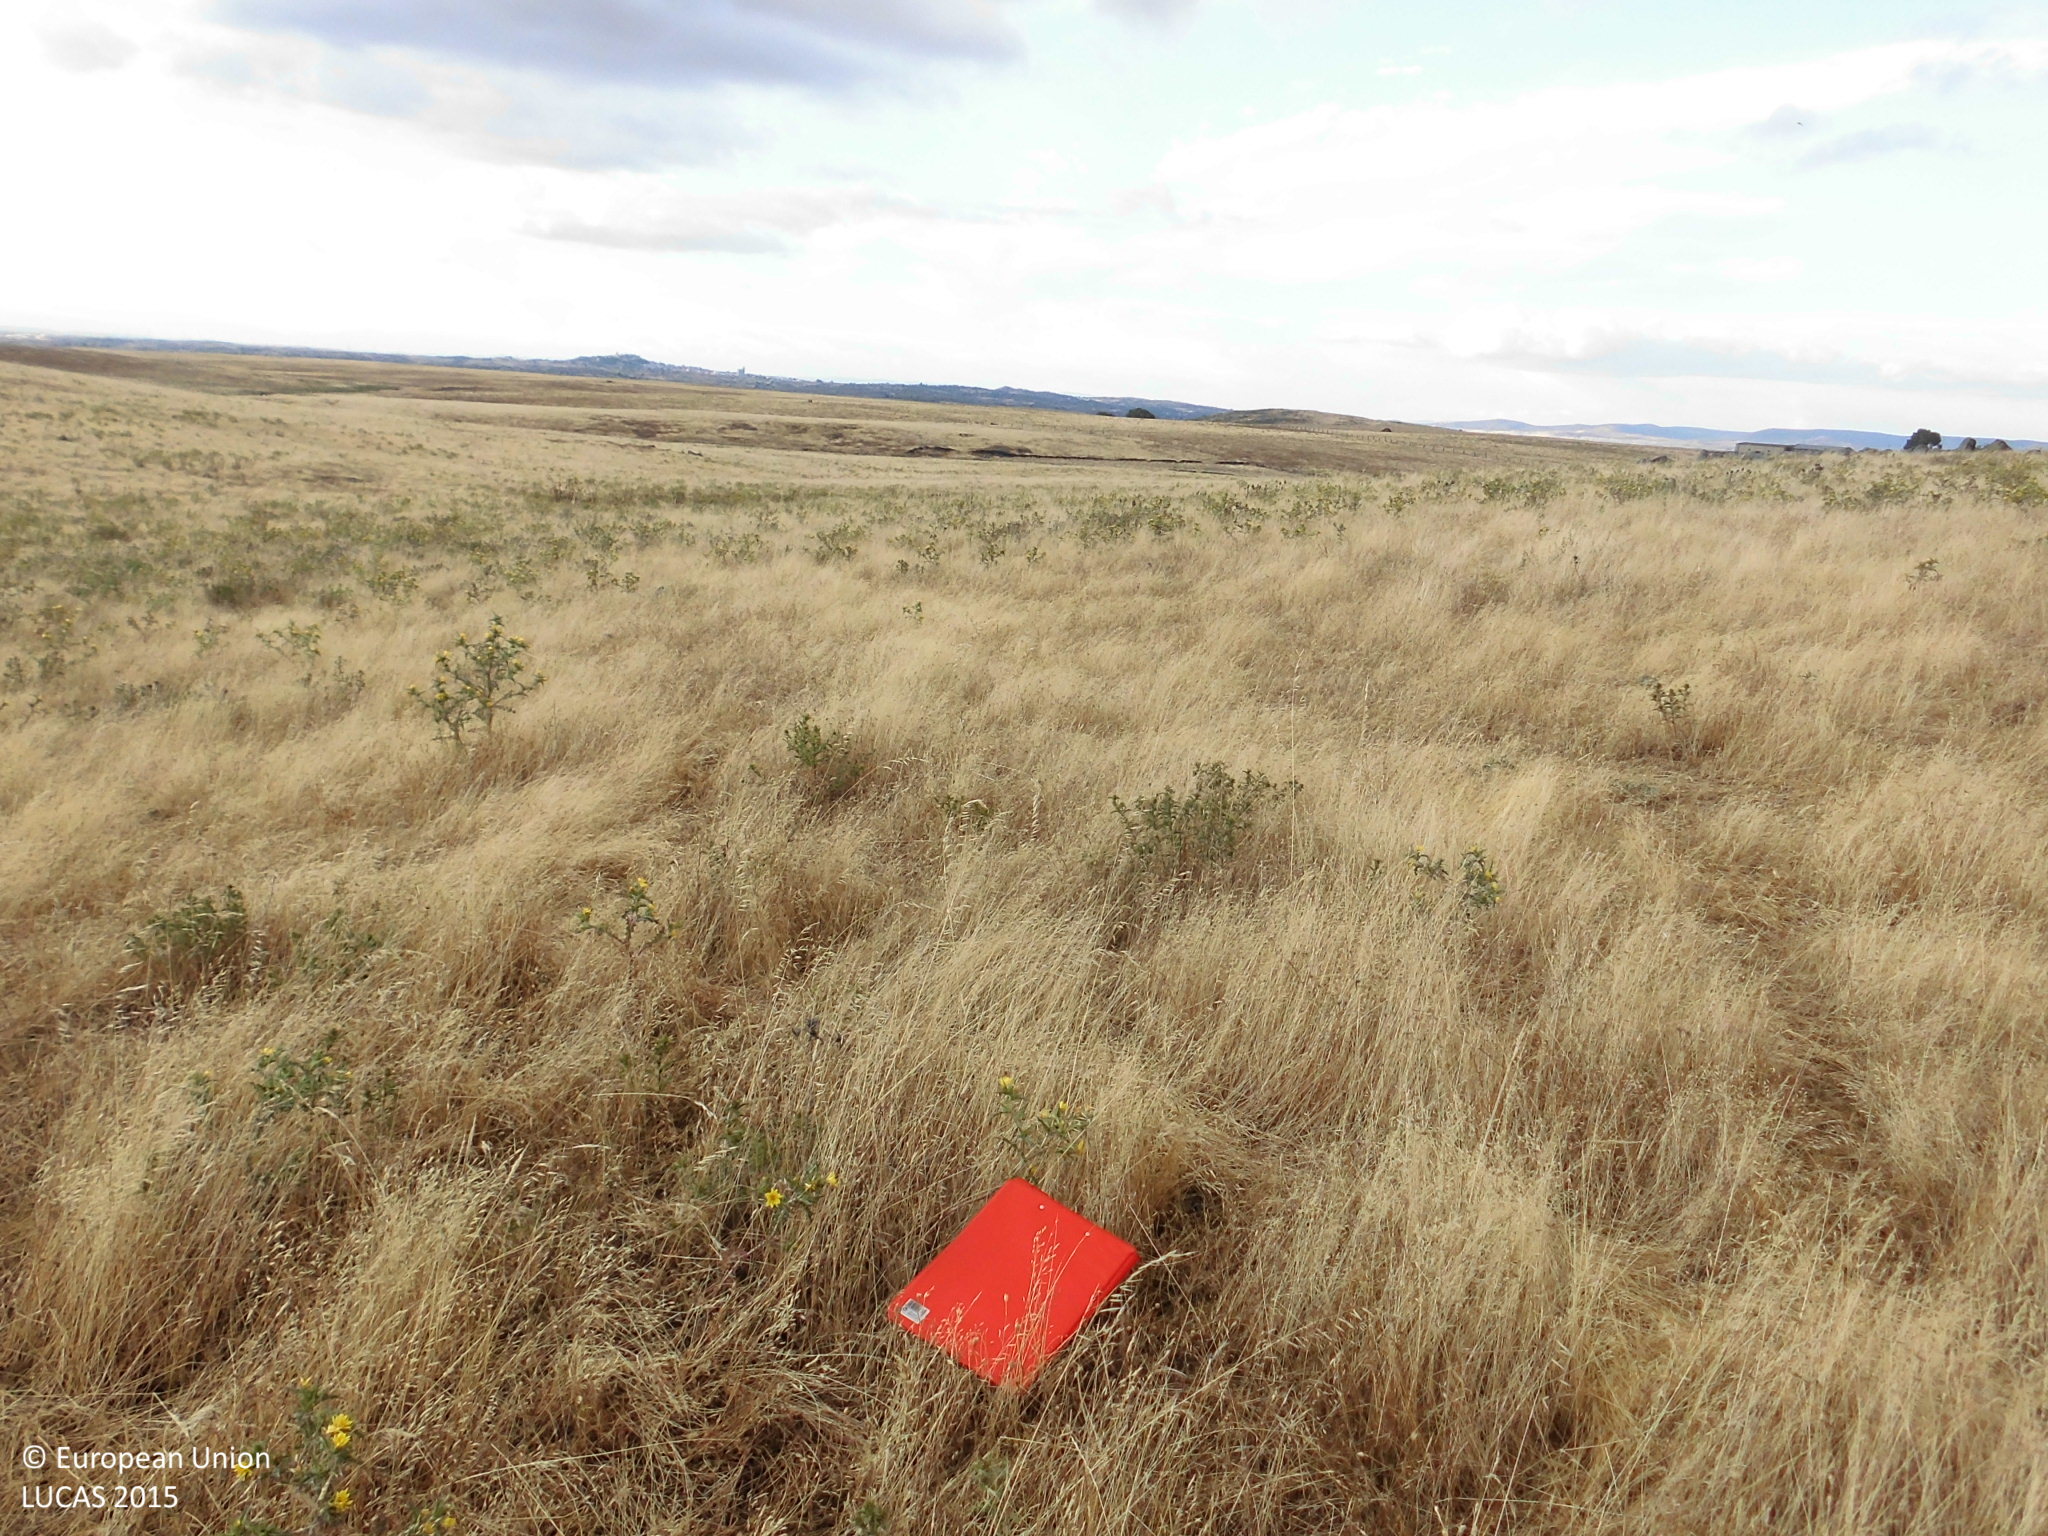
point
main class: Grassland
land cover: Grassland without tree/shrub cover
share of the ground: > 75 %
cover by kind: herbaceous plants 100 %
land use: Agriculture (excluding fallow land and kitchen gardens)
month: June
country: ES
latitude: 39.3800
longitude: -5.9272
